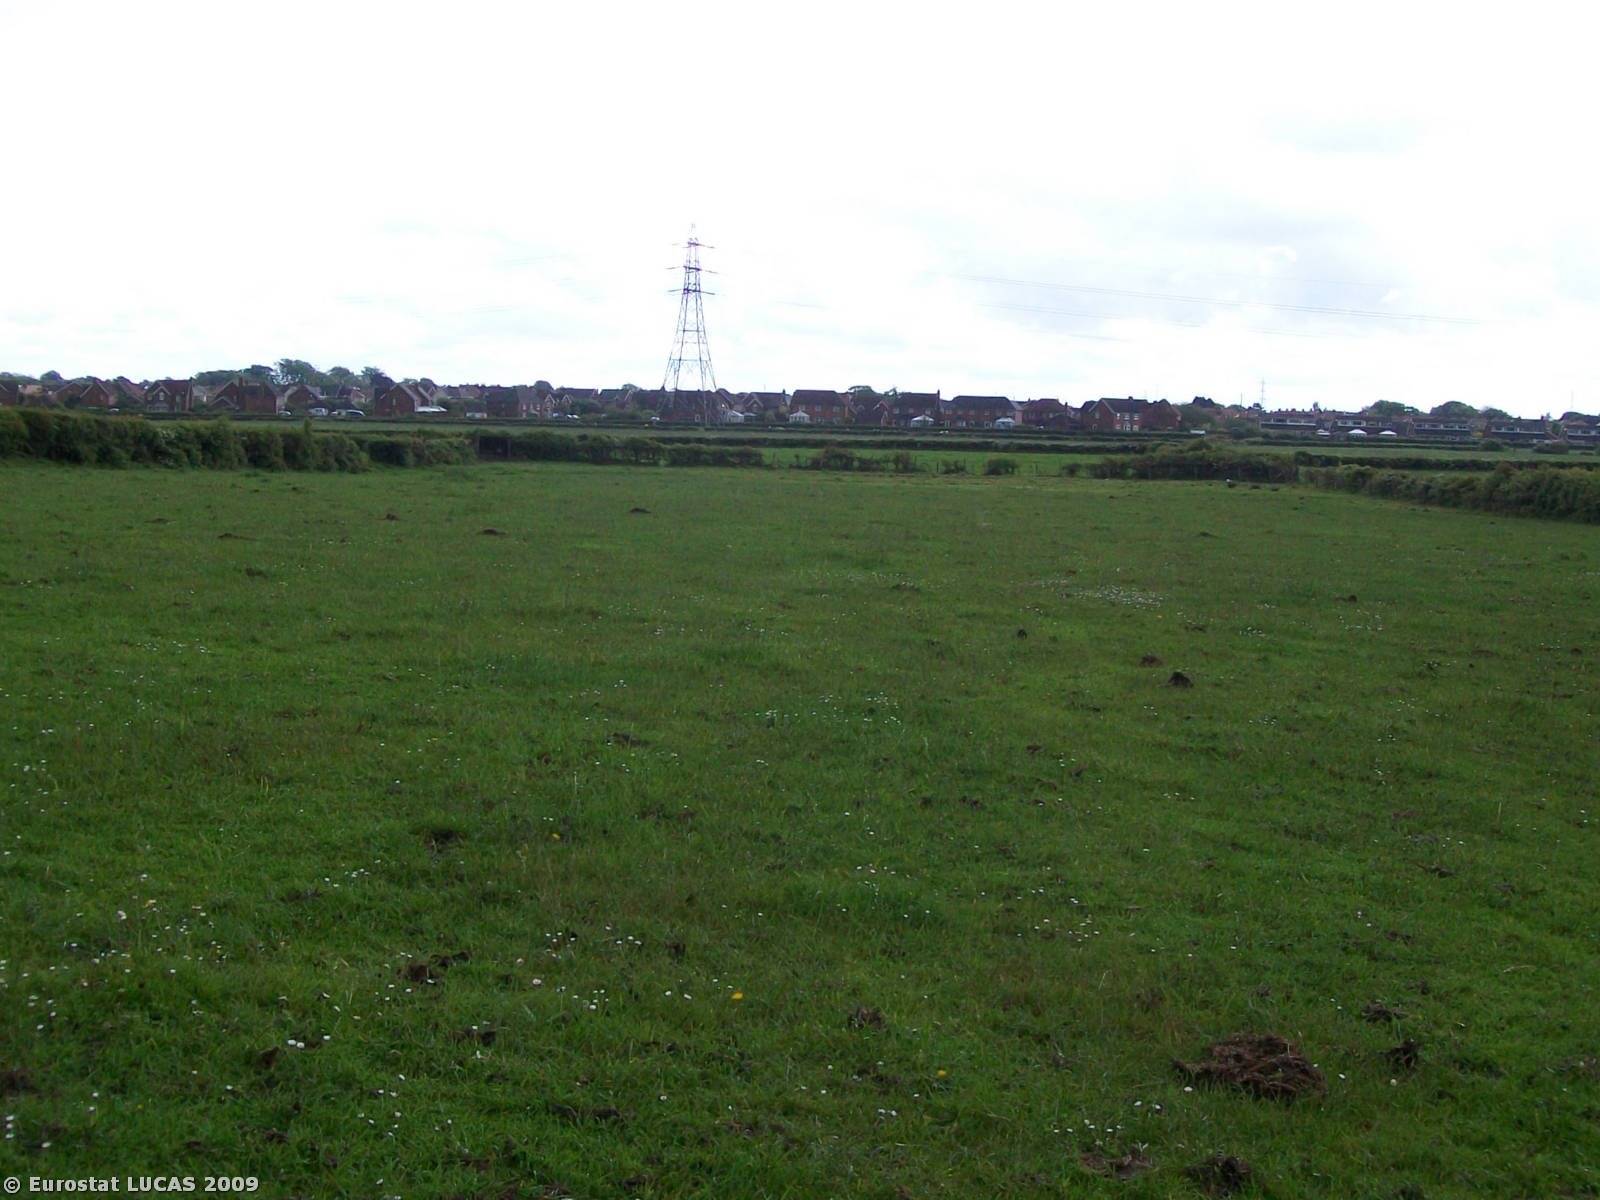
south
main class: Grassland
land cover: Grassland without tree/shrub cover
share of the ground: > 75 %
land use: Agriculture (excluding fallow land and kitchen gardens)
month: May
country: GB
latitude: 53.8622
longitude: -3.0137
